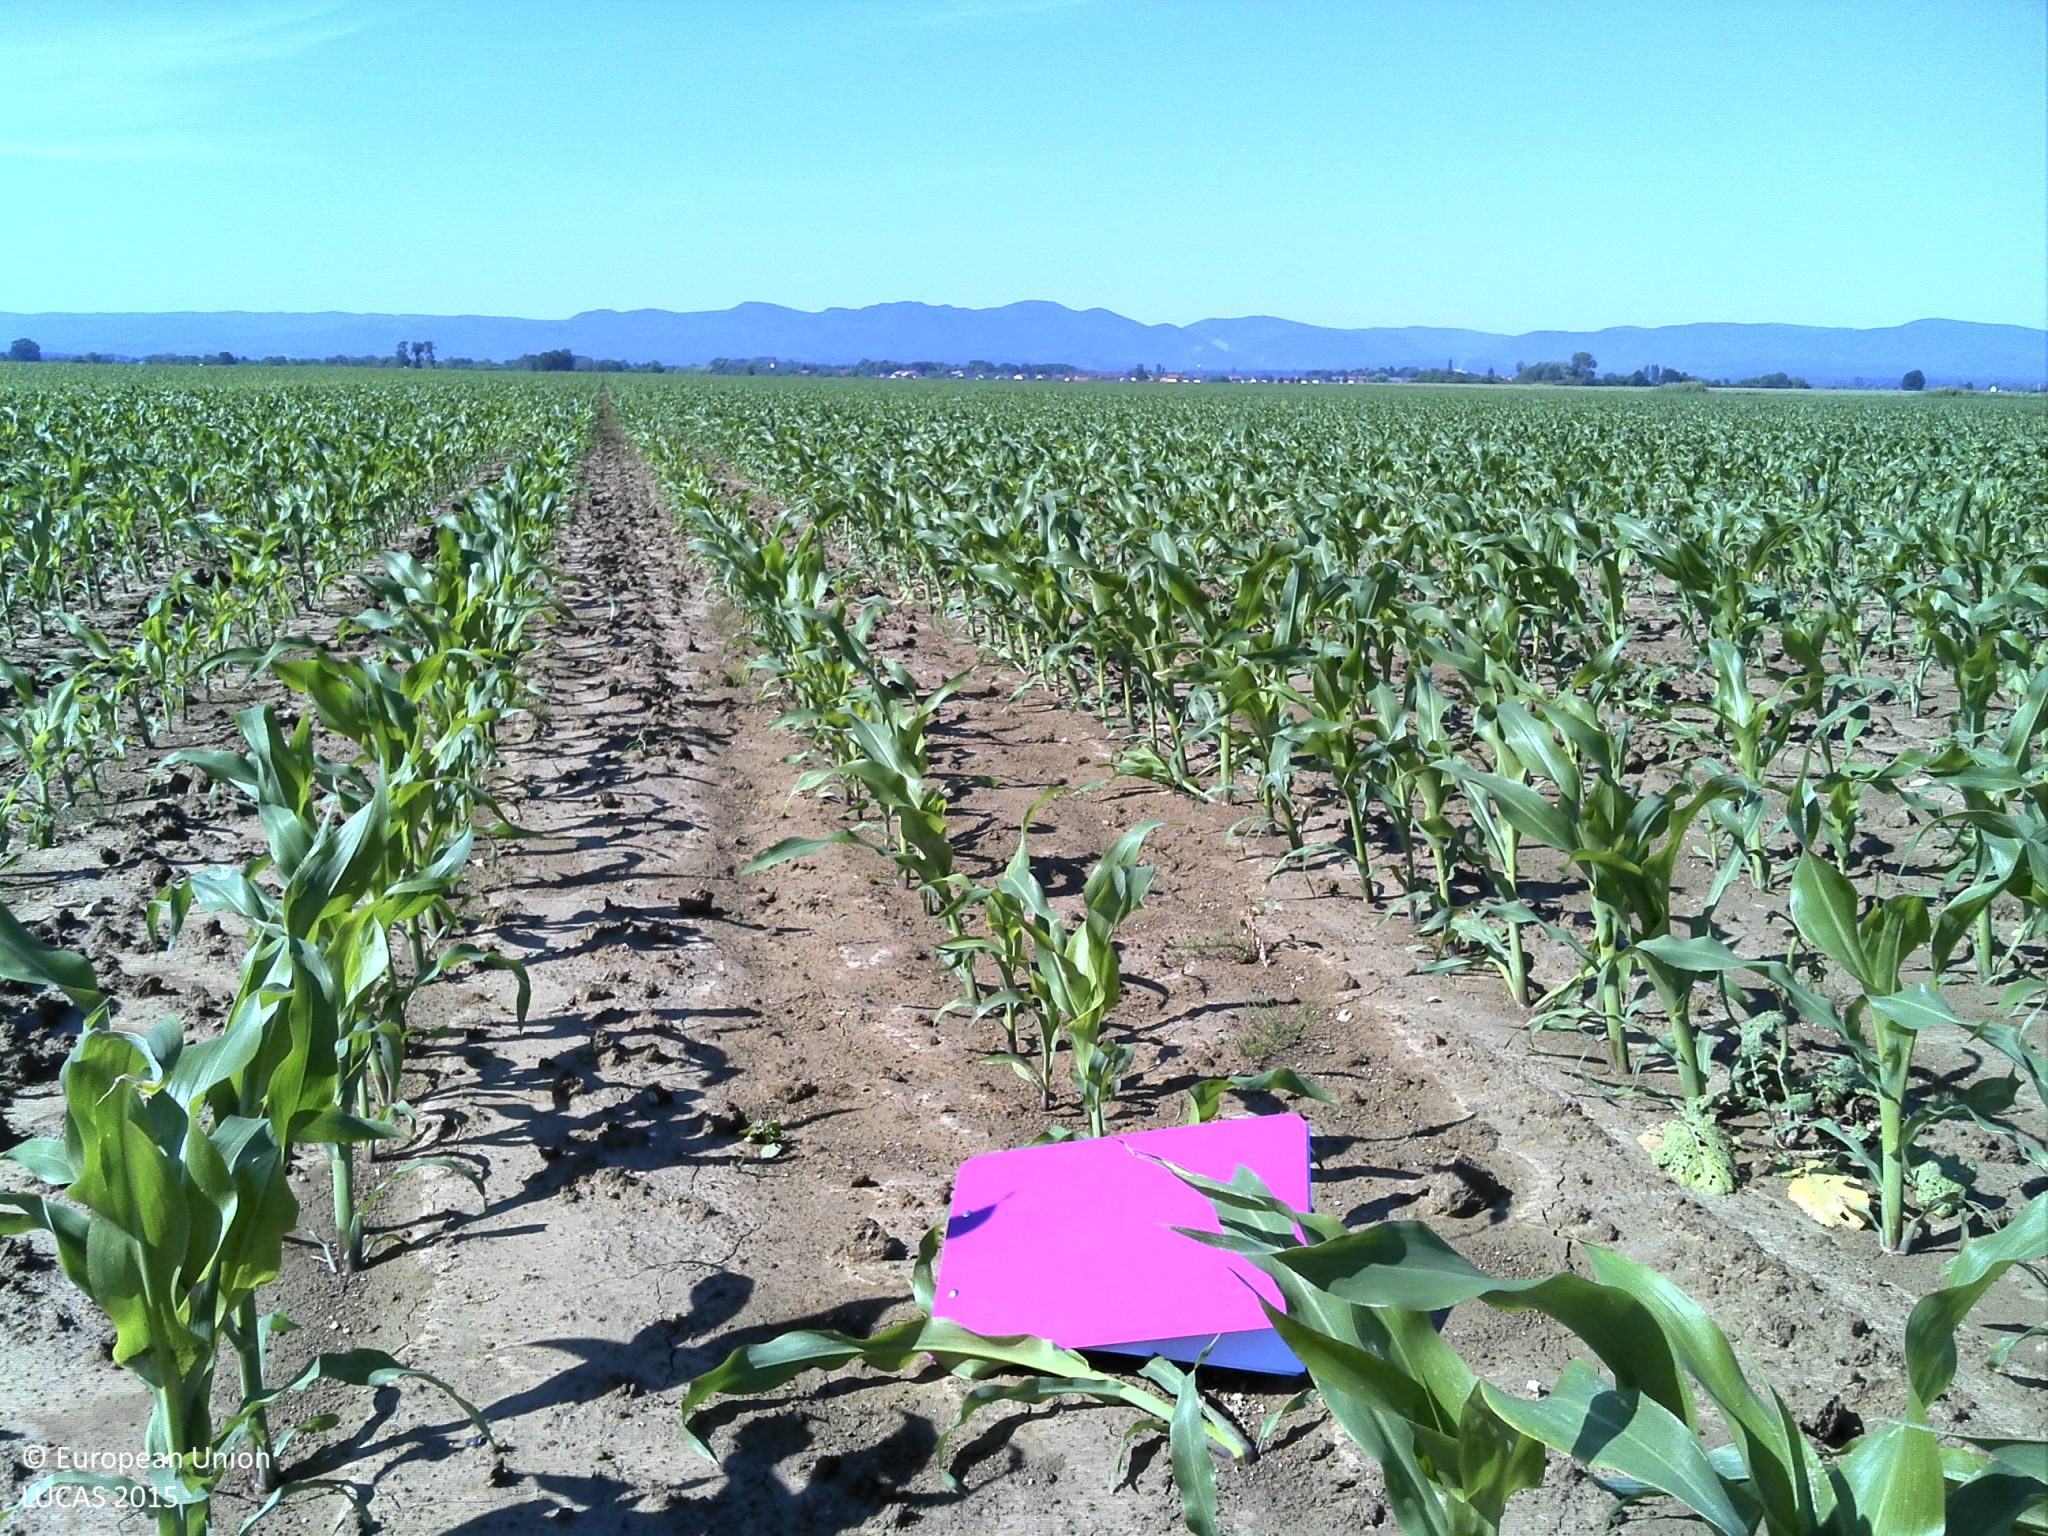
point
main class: Cropland
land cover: Maize
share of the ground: 50 - 75 %
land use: Agriculture (excluding fallow land and kitchen gardens)
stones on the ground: < 10 %
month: May
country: HR
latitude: 45.6014
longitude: 17.9656
